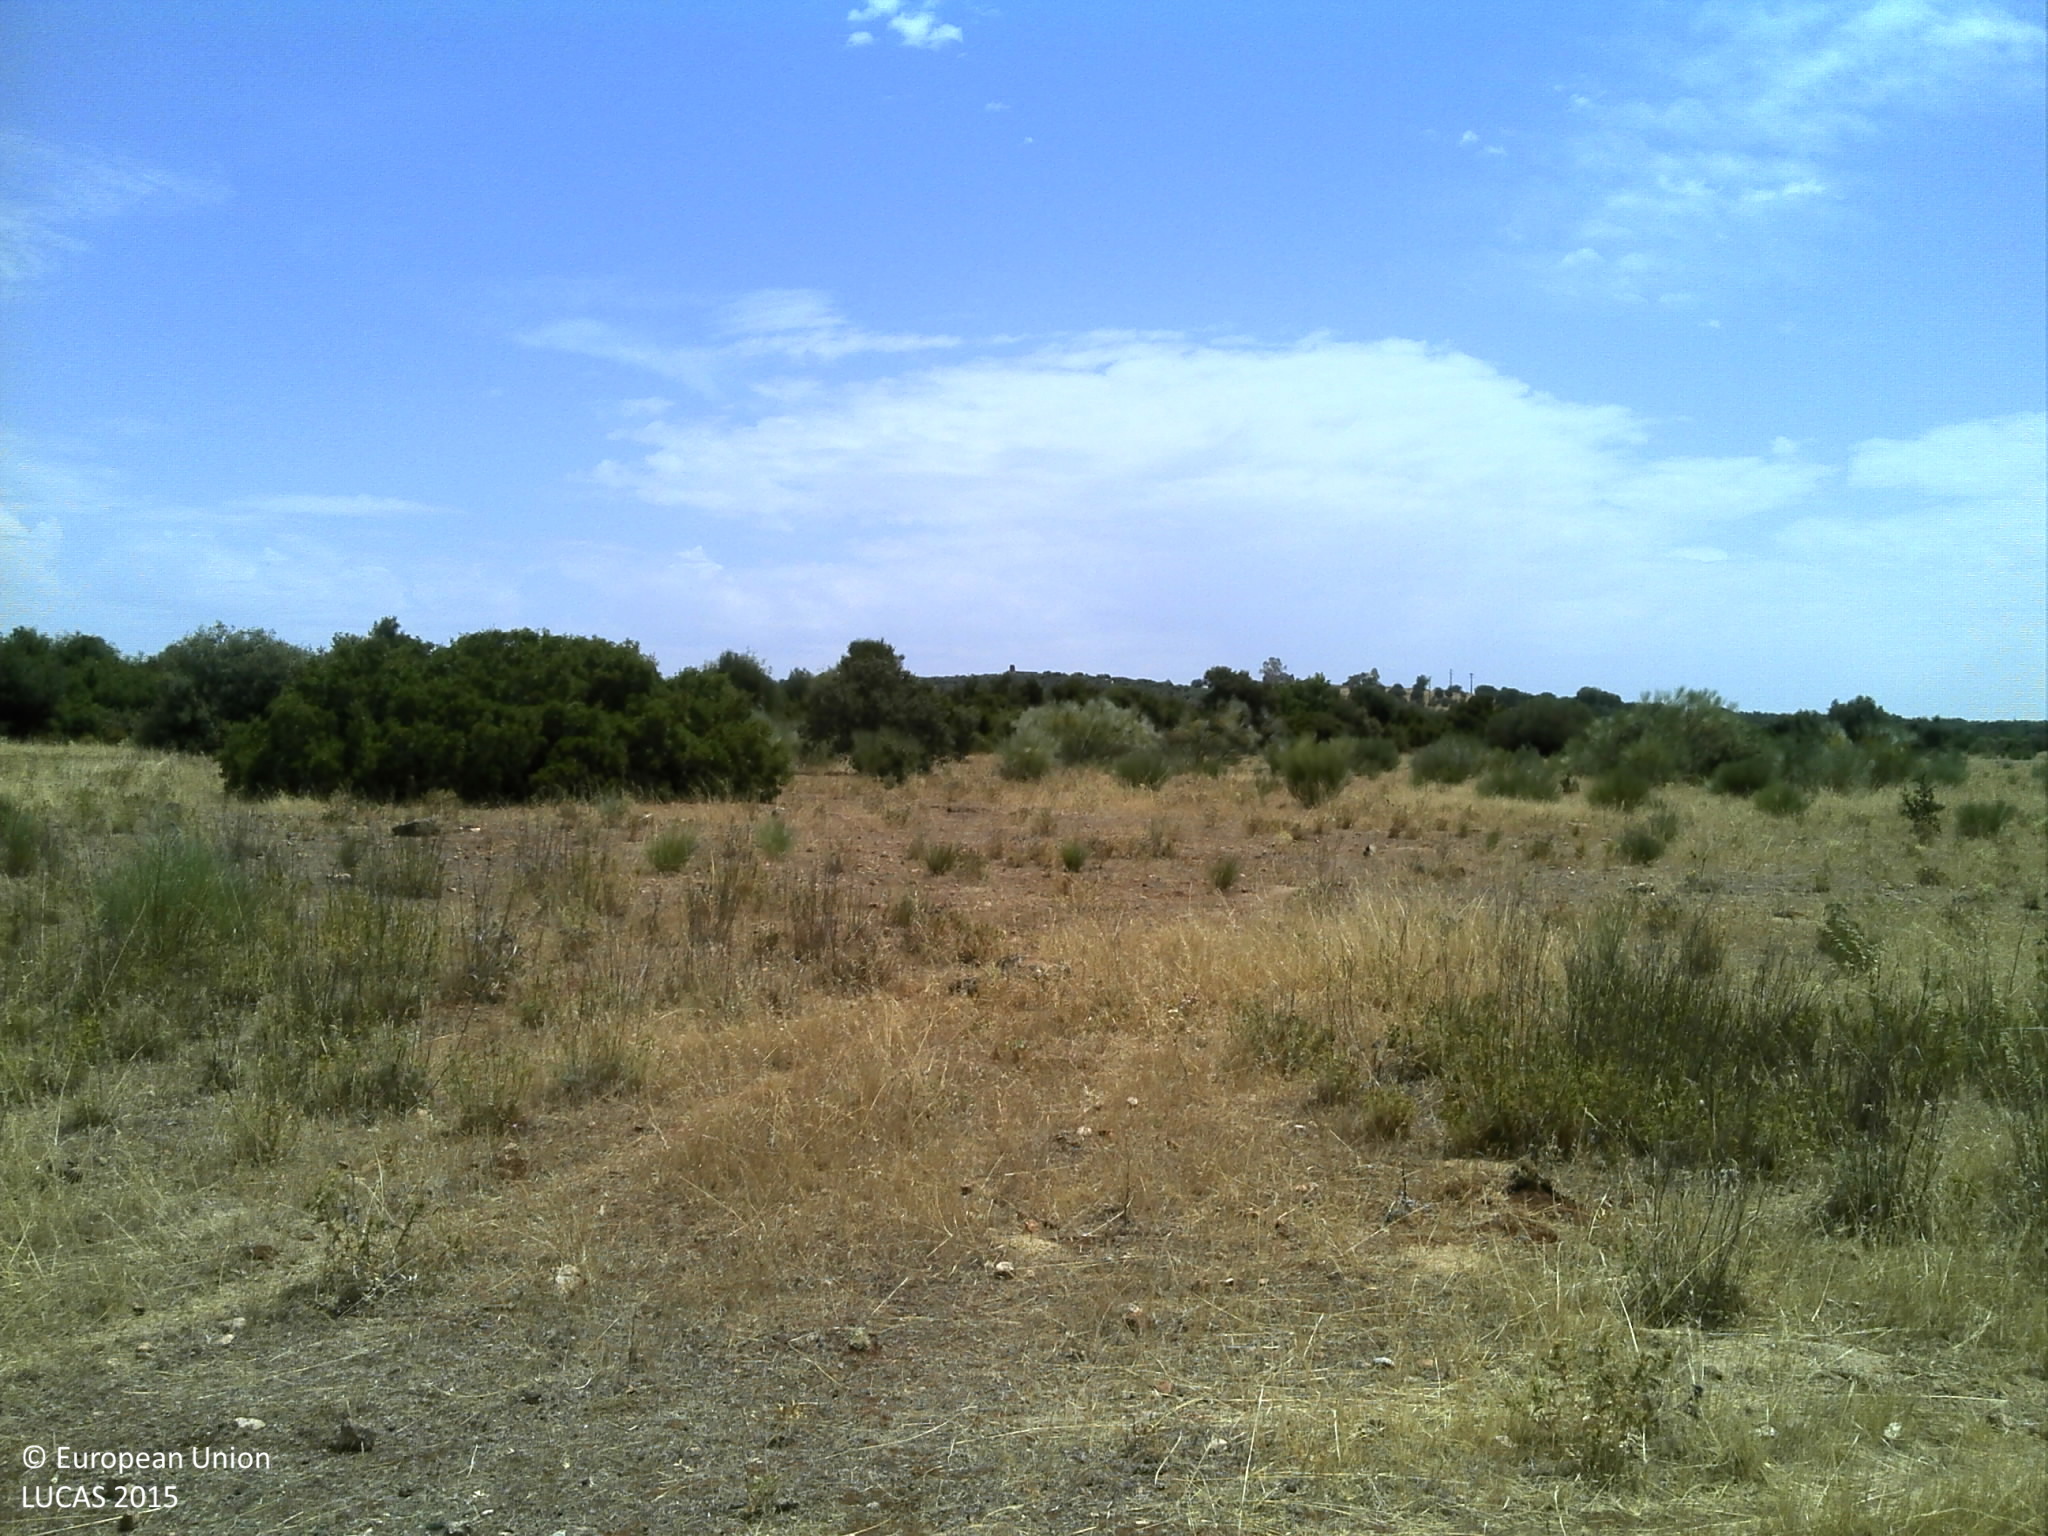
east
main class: Grassland
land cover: Grassland with sparse tree/shrub cover
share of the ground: 25 - 50 %
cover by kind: unconsolidated bare surface 50 %, herbaceous plants 40 %, broadleaved forest trees 5 %, shrubs 5 %
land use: Agriculture (excluding fallow land and kitchen gardens)
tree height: < 5 m
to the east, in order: Grassland with sparse tree/shrub cover; Tracks; Grass margins; Shrubland with sparse tree cover; Other bare soil; Nuts trees; Vineyards; Olive groves; Tracks; Olive groves; Vineyards
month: July
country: PT
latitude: 38.8360
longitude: -7.5583
